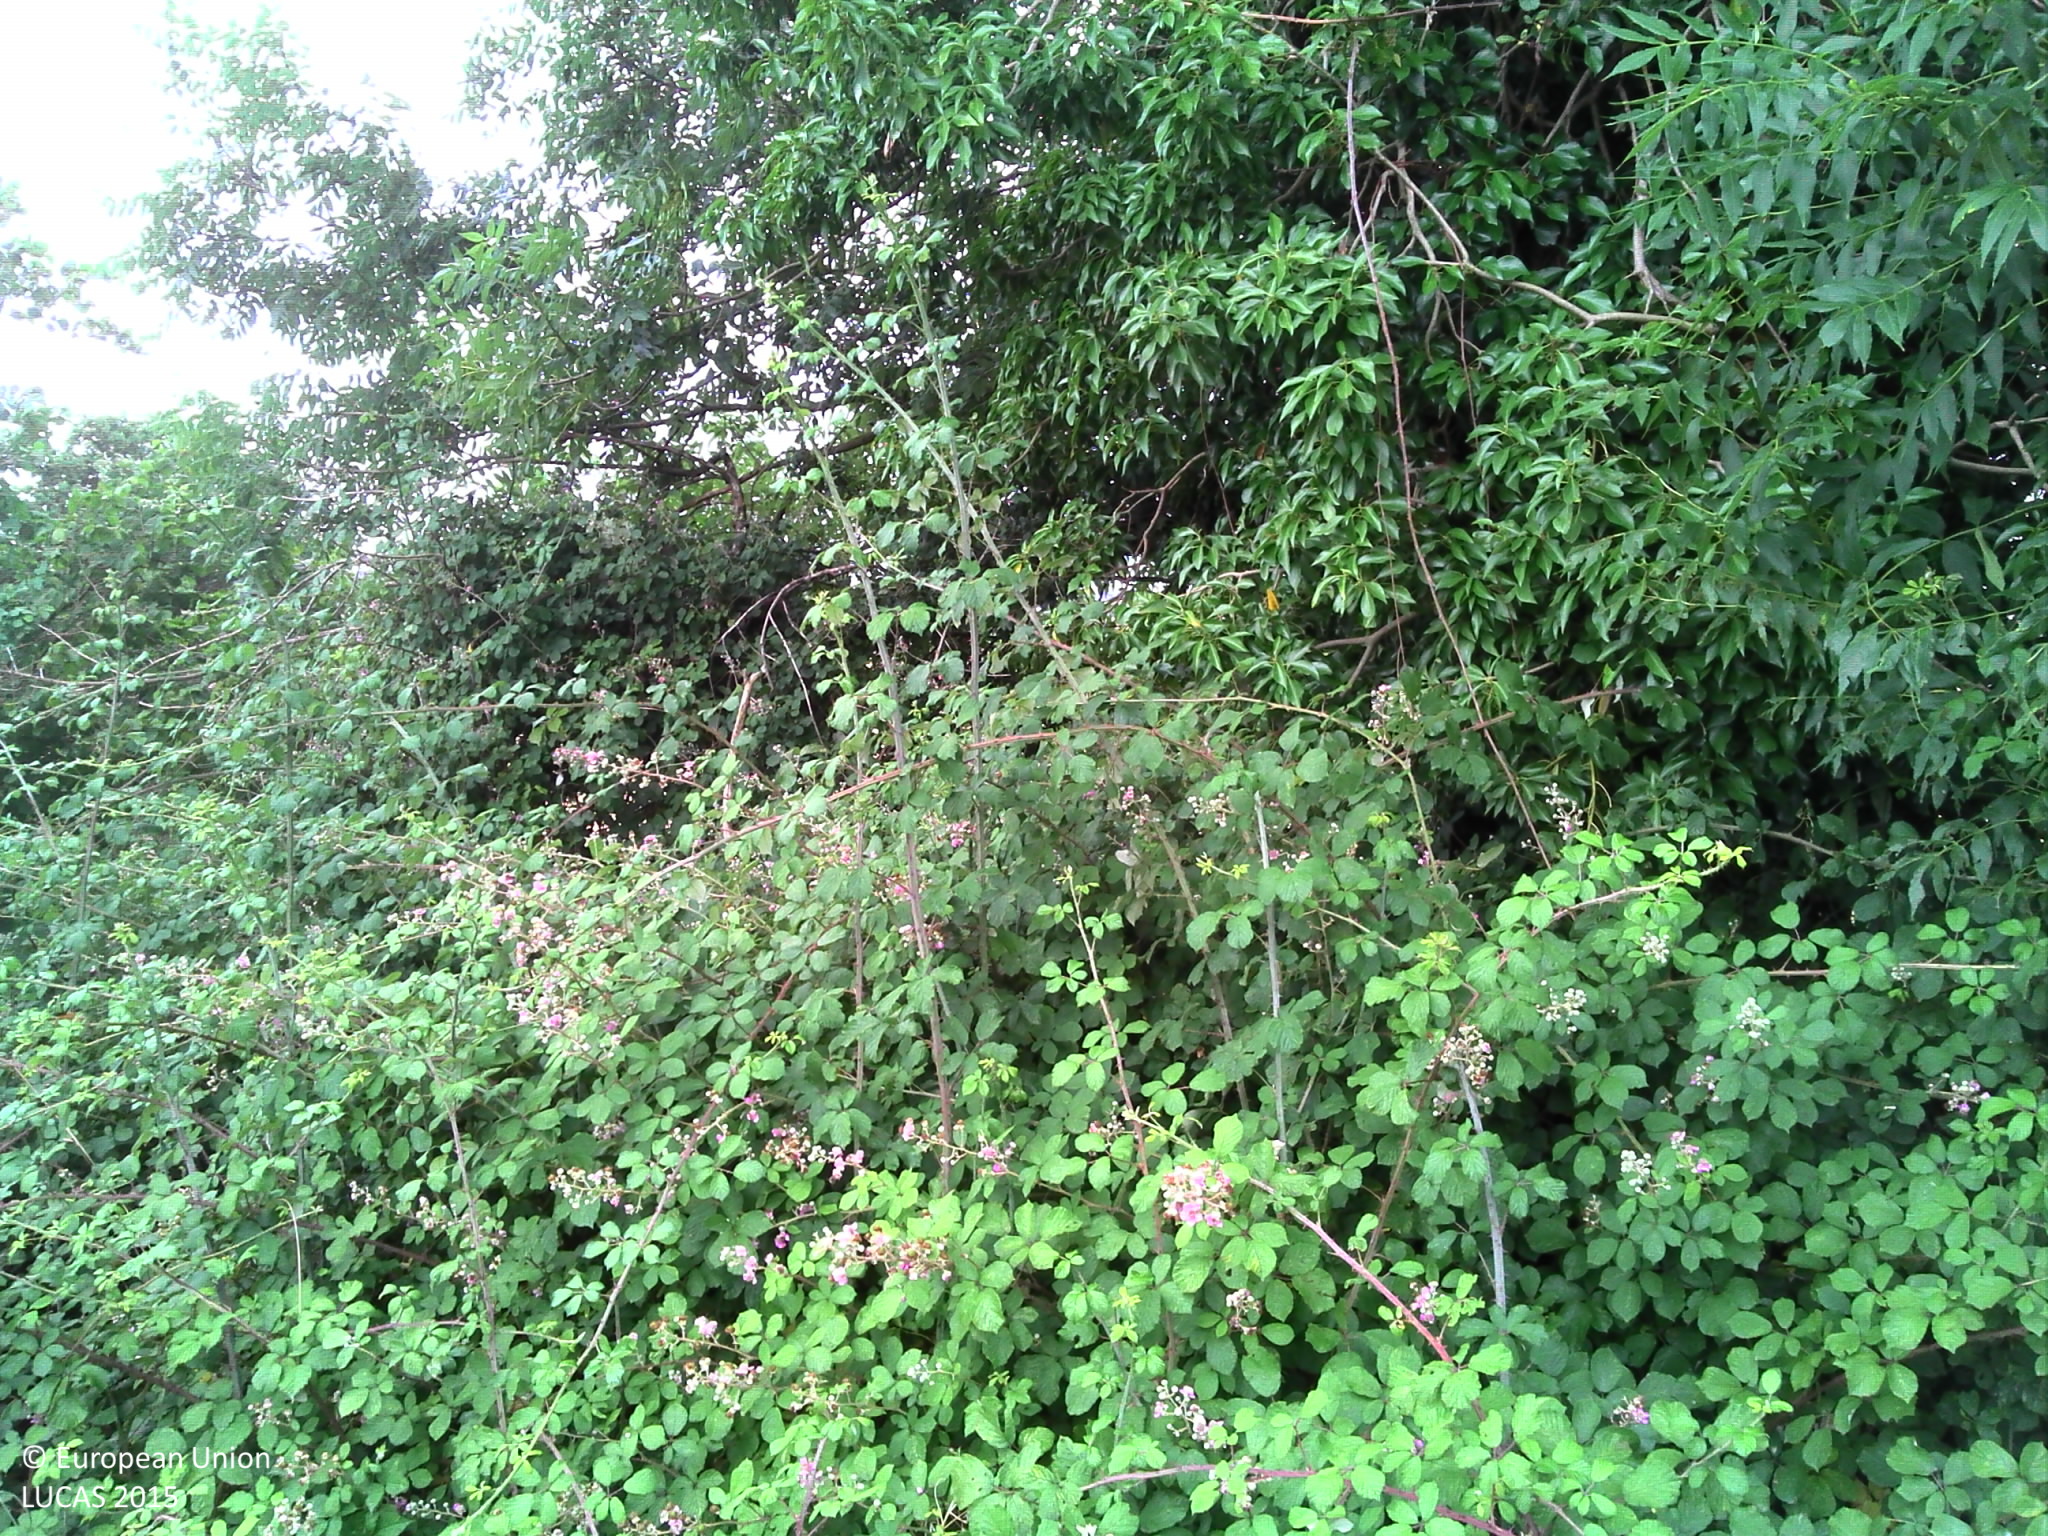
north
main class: Woodland
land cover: Broadleaved woodland
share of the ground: > 75 %
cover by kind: herbaceous plants 50 %, shrubs 35 %, broadleaved forest trees 15 %
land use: Semi-natural and natural areas not in use
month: July
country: FR
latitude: 47.8343
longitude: -1.3585
